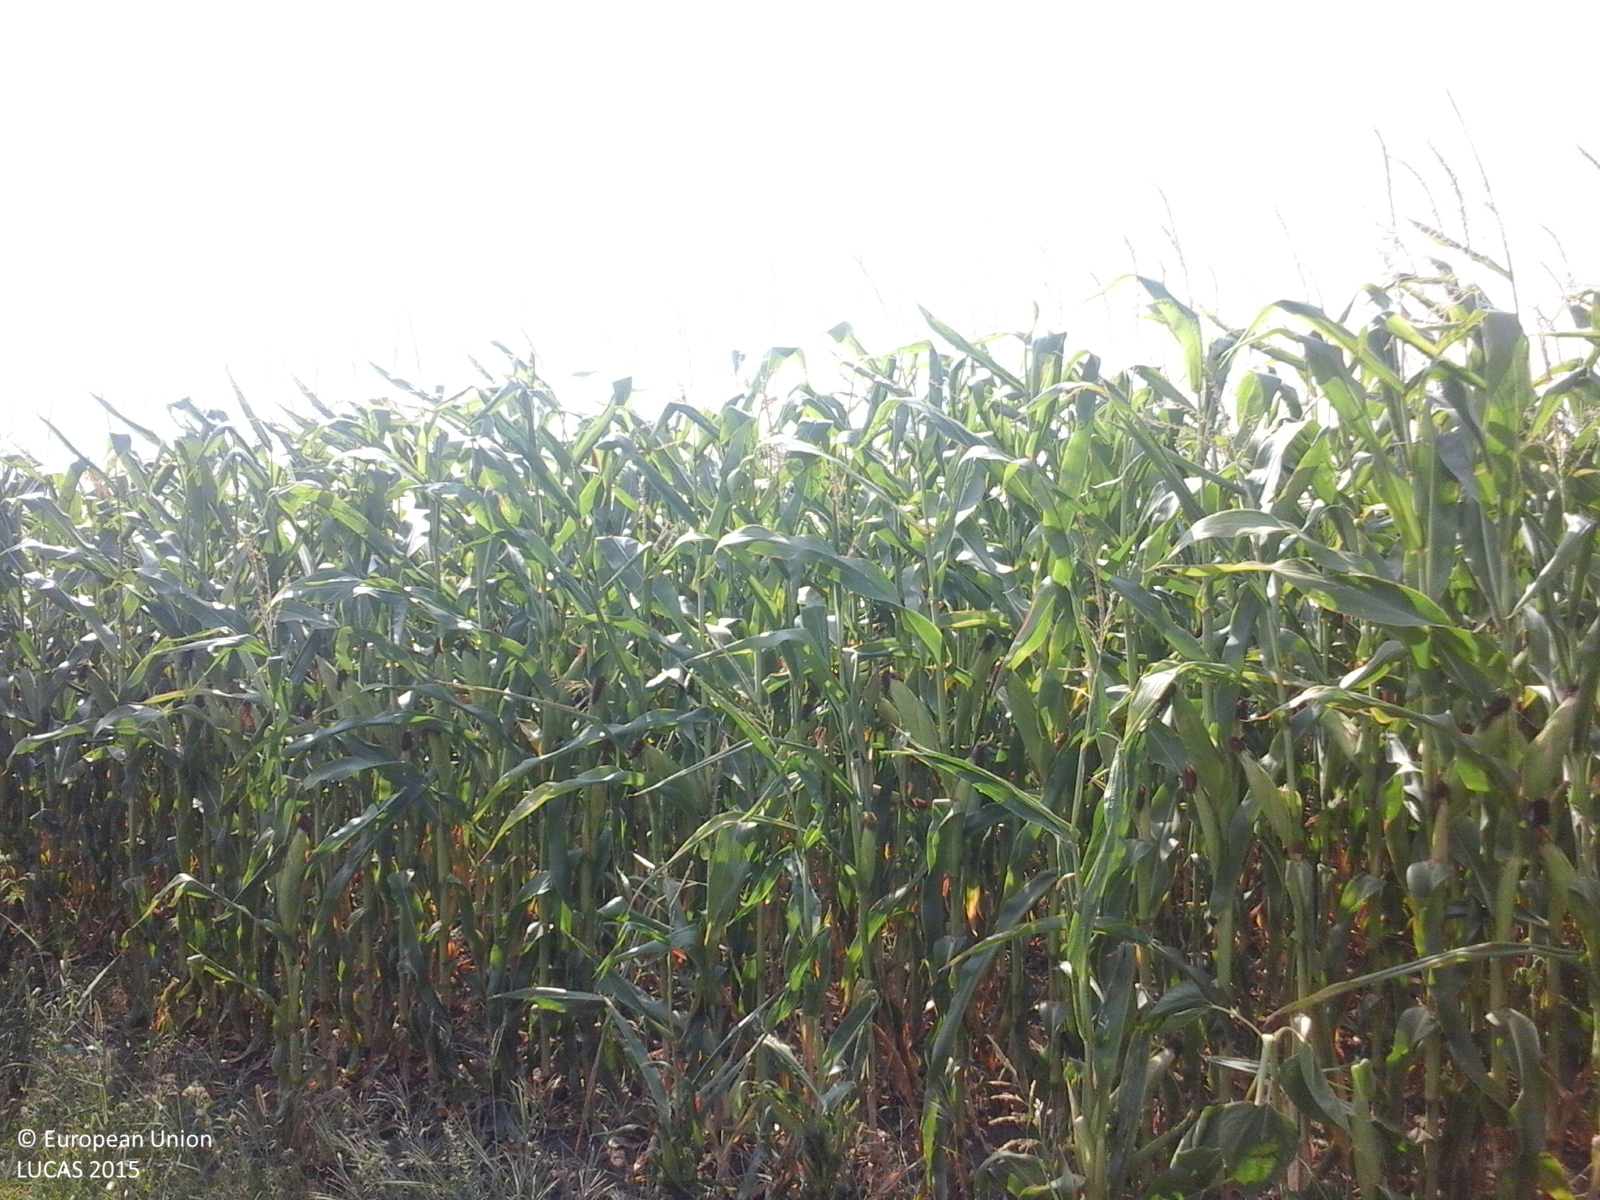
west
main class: Cropland
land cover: Maize
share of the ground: > 75 %
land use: Agriculture (excluding fallow land and kitchen gardens)
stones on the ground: < 10 %
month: August
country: RO
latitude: 45.2147
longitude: 27.4541
